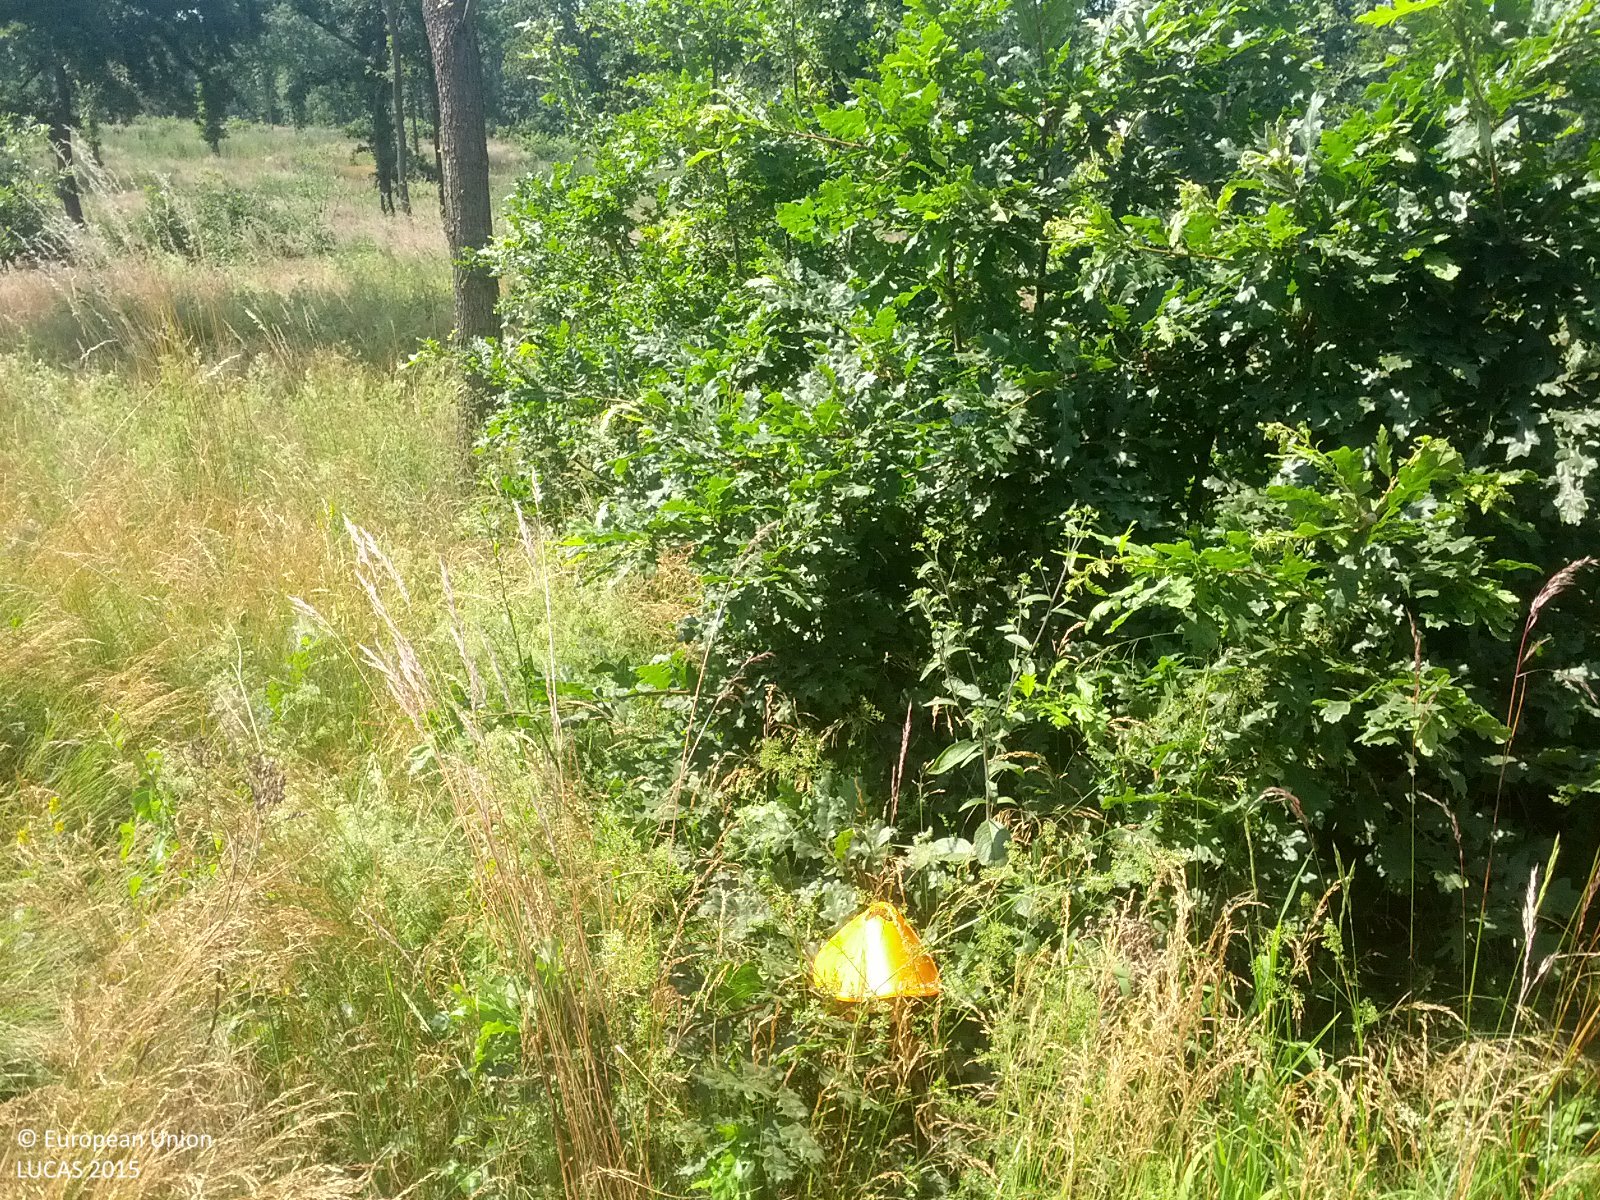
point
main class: Woodland
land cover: Broadleaved woodland
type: thermophilous deciduous forest
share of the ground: 25 - 50 %
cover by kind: herbaceous plants 65 %, broadleaved forest trees 30 %, shrubs 5 %
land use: Forestry
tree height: > 5 m
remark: Clear cut
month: July
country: AT
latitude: 48.5442
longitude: 16.6848
